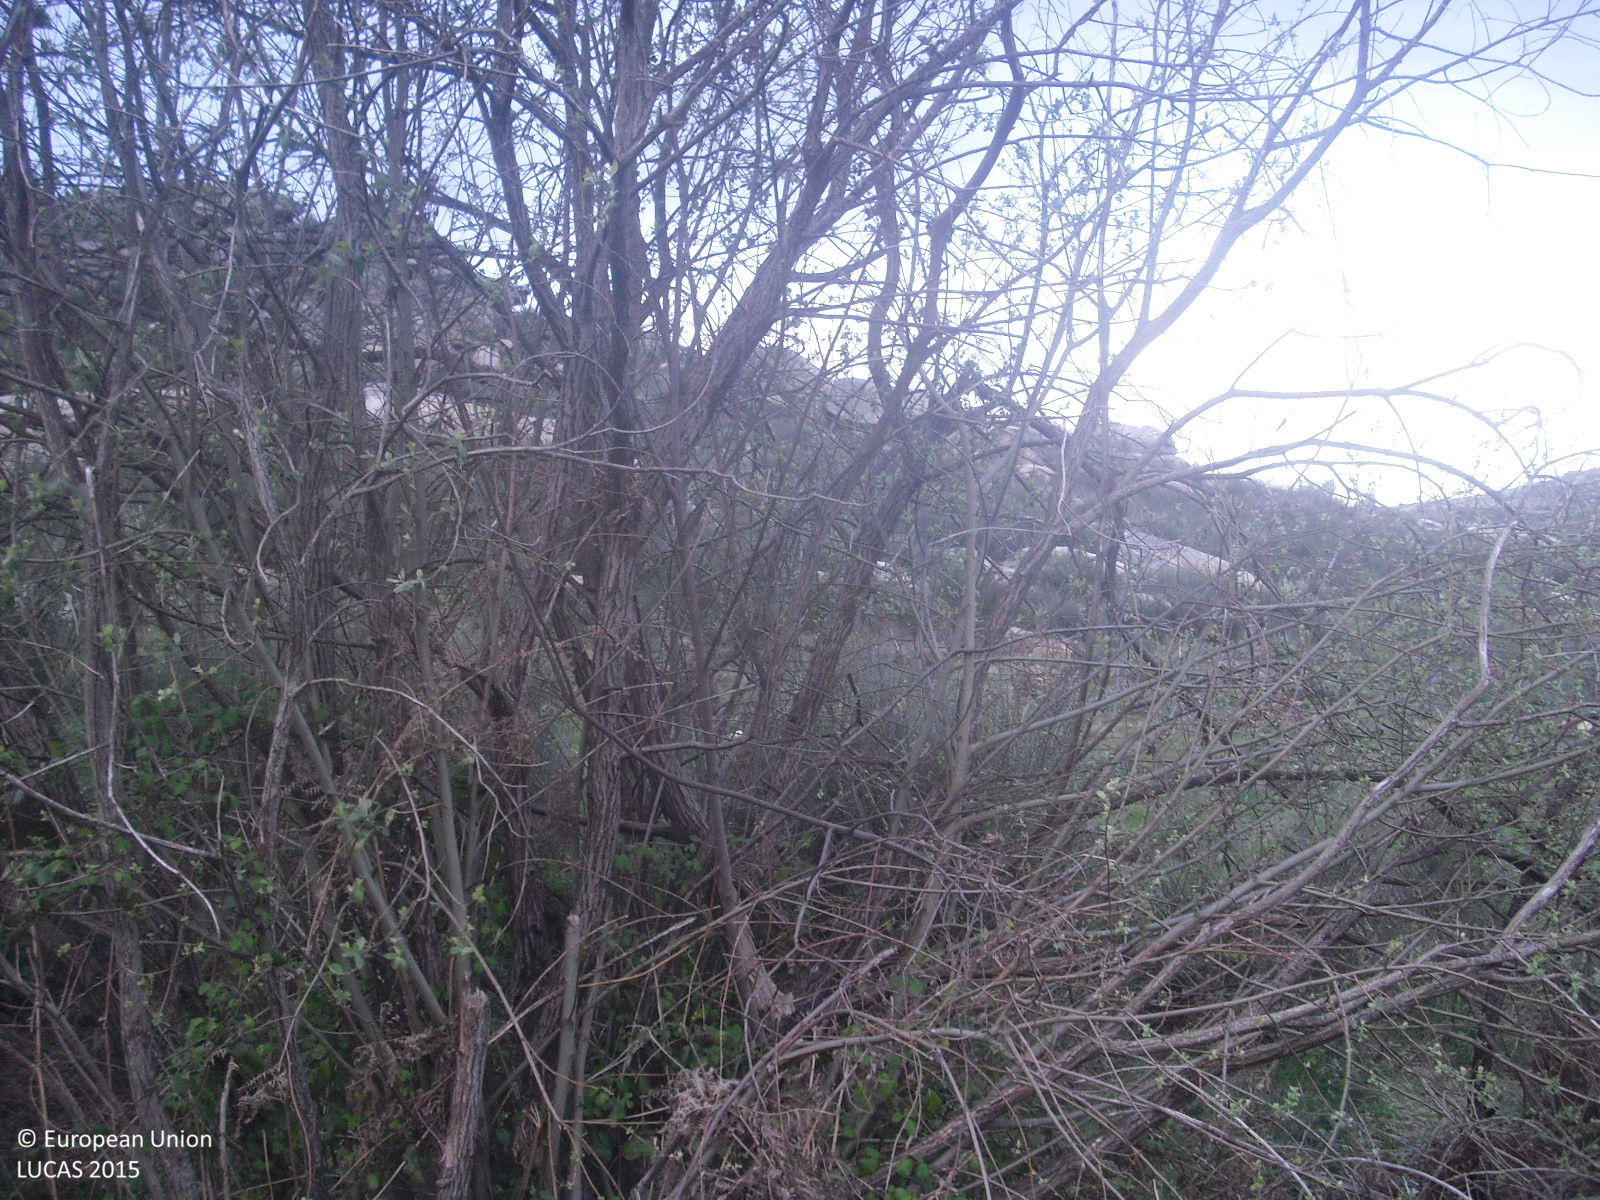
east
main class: Grassland
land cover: Grassland with sparse tree/shrub cover
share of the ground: 50 - 75 %
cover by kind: herbaceous plants 85 %, shrubs 10 %, coniferous forest trees 5 %
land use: Forestry
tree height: < 5 m
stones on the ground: < 10 %
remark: Burnt area
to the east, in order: Grassland with sparse tree/shrub cover; Rivers and streams; Grassland with sparse tree/shrub cover; Shrubland without tree cover; Rock outcrops; Shrubland without tree cover; Rock outcrops; Shrubland without tree cover; Rock outcrops; Pine dominated coniferous woodland; Grassland without tree/shrub cover; Other bare soil; Tracks; Shrubland without tree cover; Grassland with sparse tree/shrub cover
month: April
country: ES
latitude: 42.0418
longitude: -7.8928
